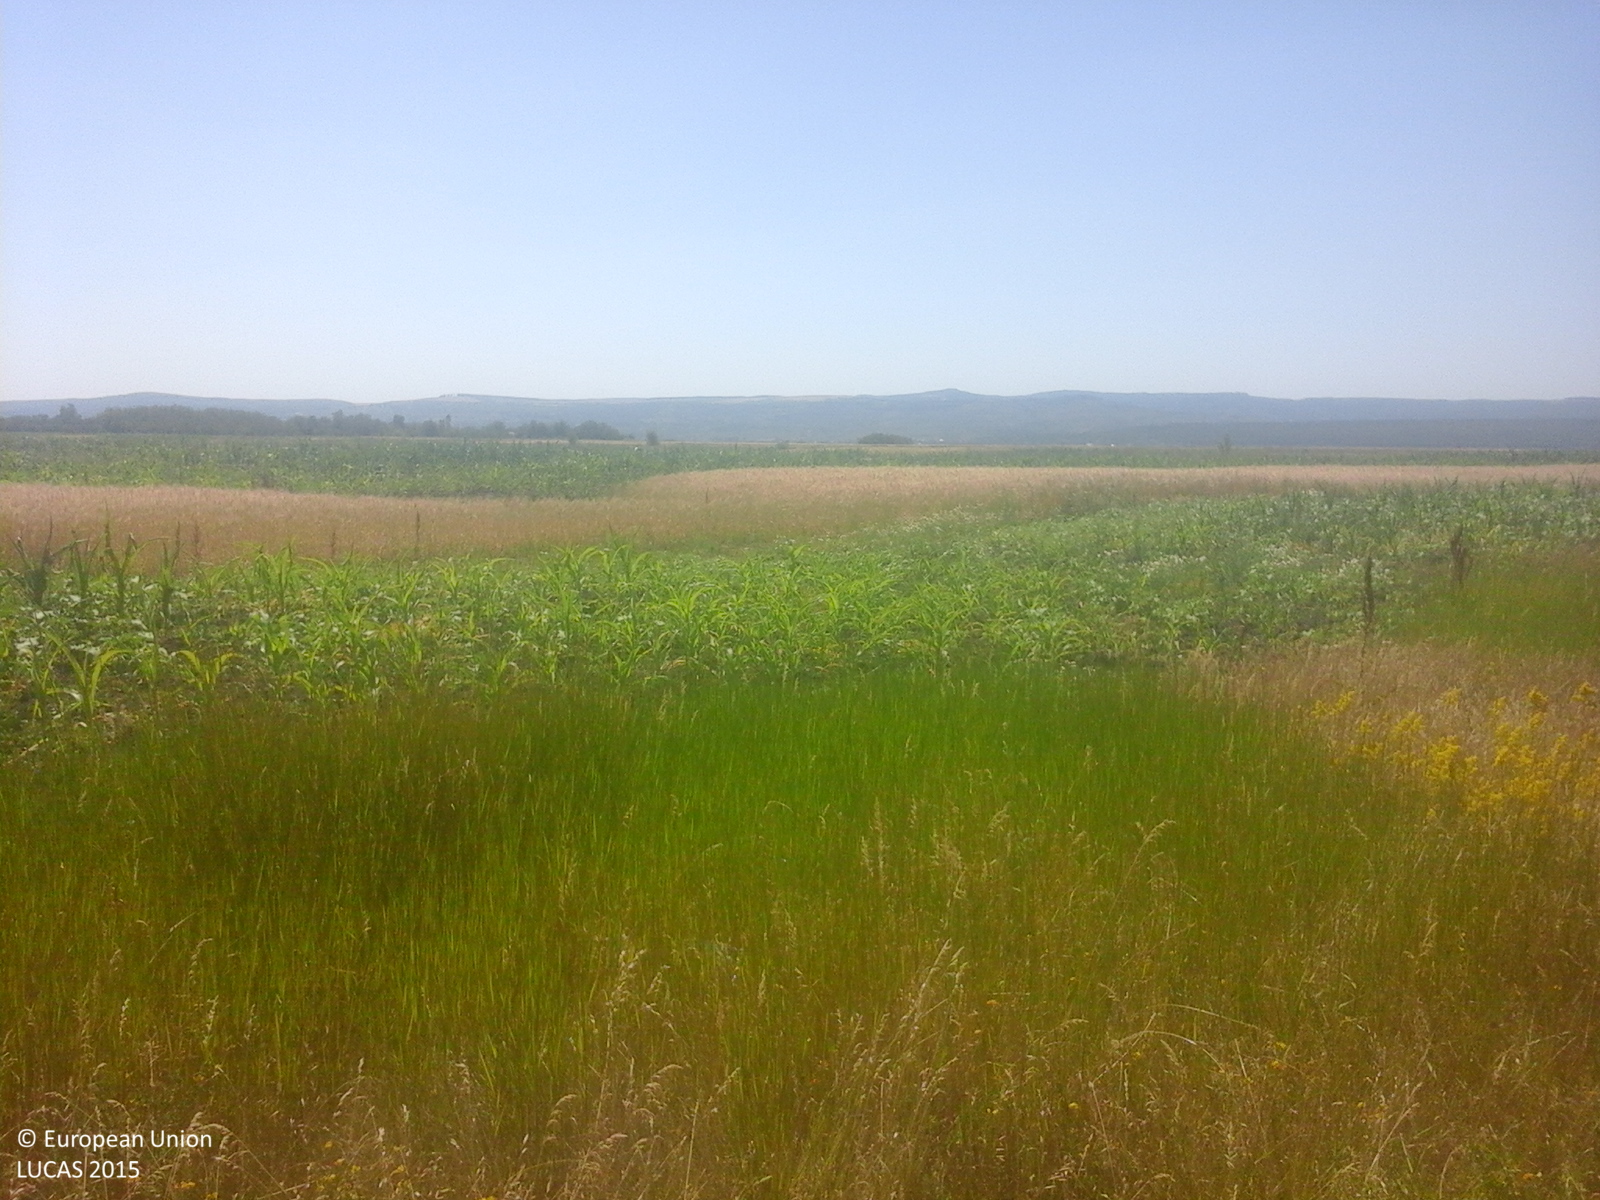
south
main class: Grassland
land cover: Grassland without tree/shrub cover
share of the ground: > 75 %
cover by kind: herbaceous plants 100 %
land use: Agriculture (excluding fallow land and kitchen gardens)
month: June
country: RO
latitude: 47.0793
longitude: 27.8676
